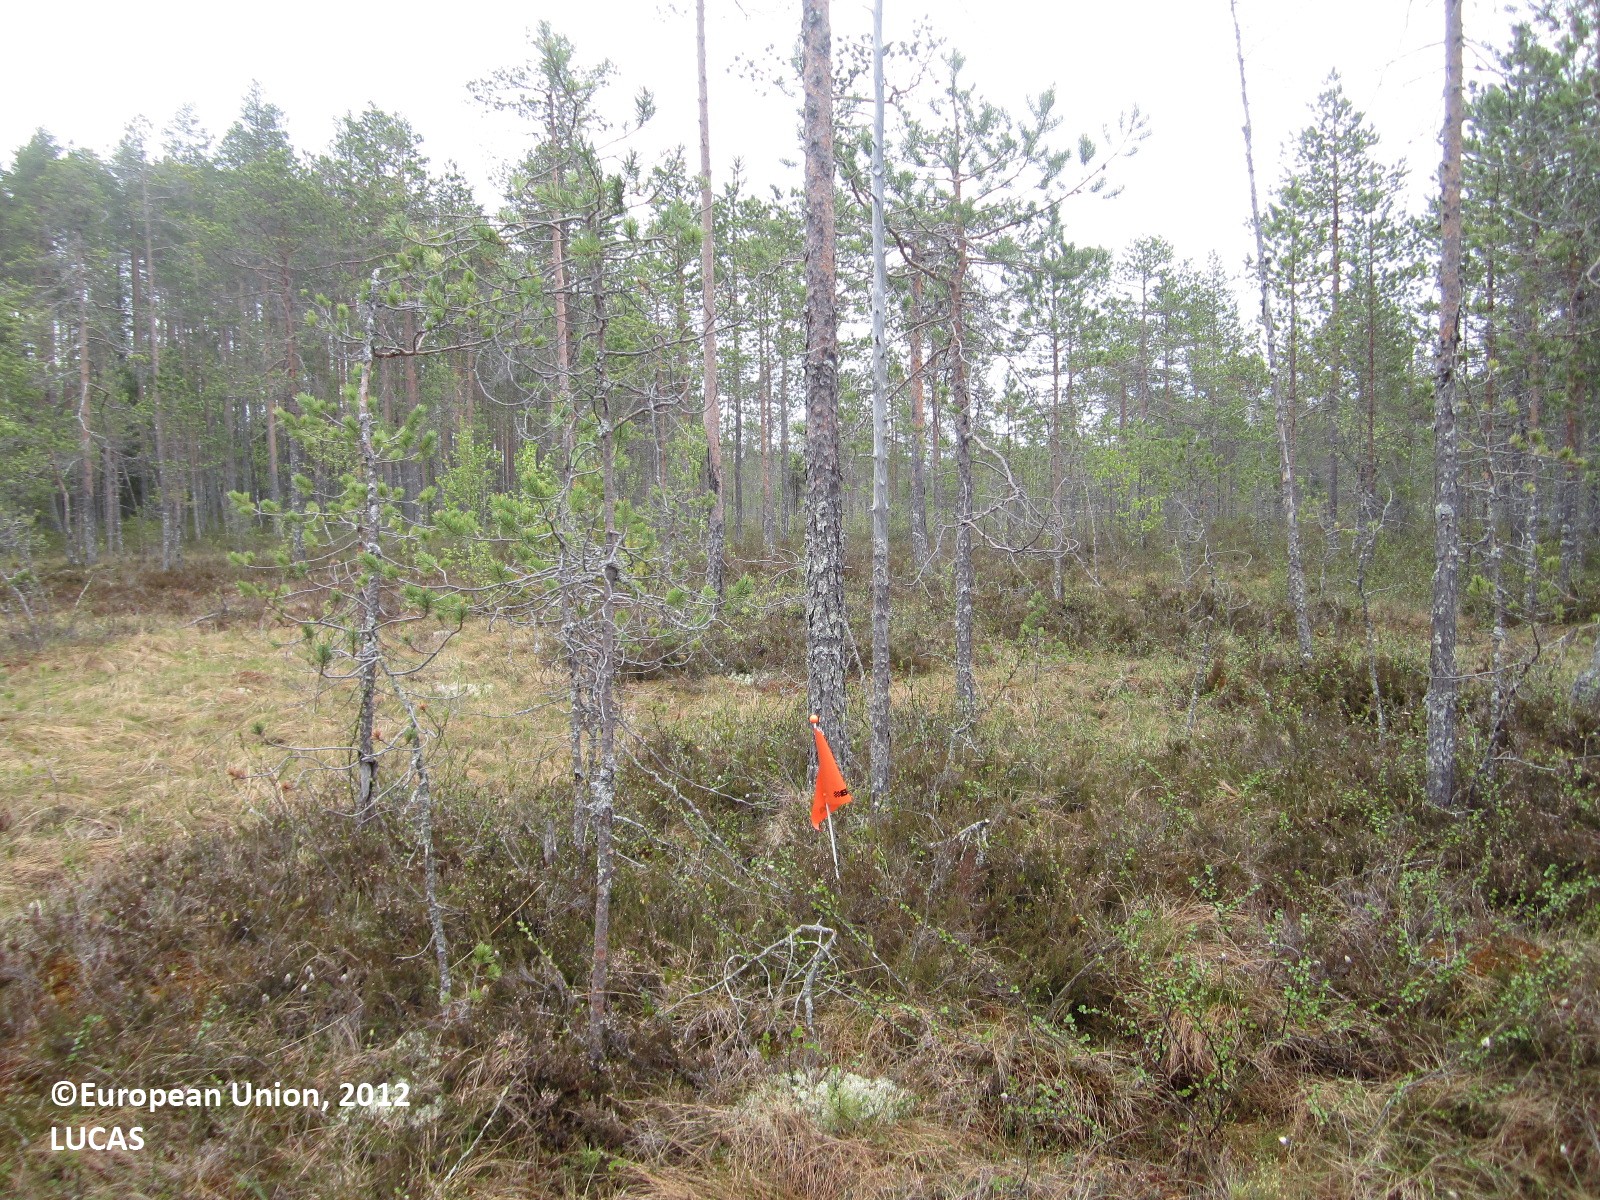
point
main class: Woodland
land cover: Pine dominated coniferous woodland
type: mire and swamp forests
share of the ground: 10 - 25 %
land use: Semi-natural and natural areas not in use
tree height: > 5 m
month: June
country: FI
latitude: 64.6834
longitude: 28.6000
